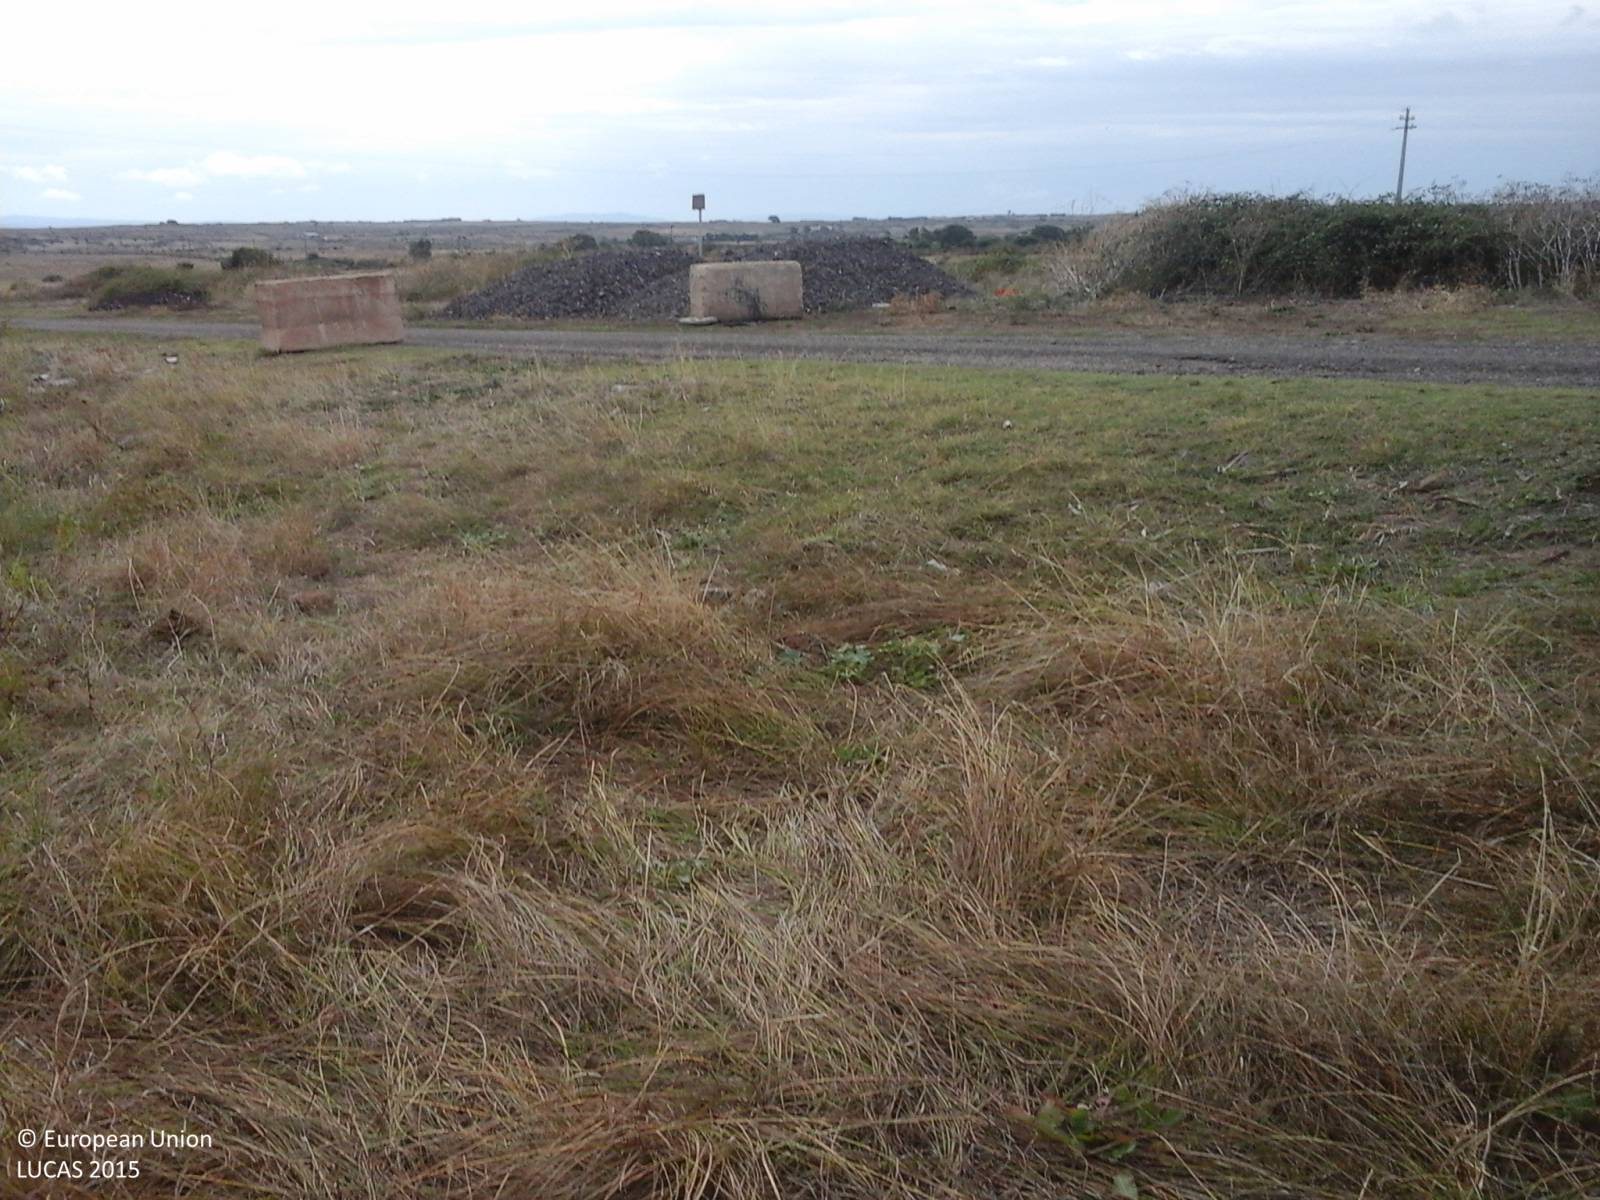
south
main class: Grassland
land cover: Grassland without tree/shrub cover
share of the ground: > 75 %
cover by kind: herbaceous plants 100 %
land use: Agriculture (excluding fallow land and kitchen gardens)
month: September
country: IT
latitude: 40.2602
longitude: 8.8186
